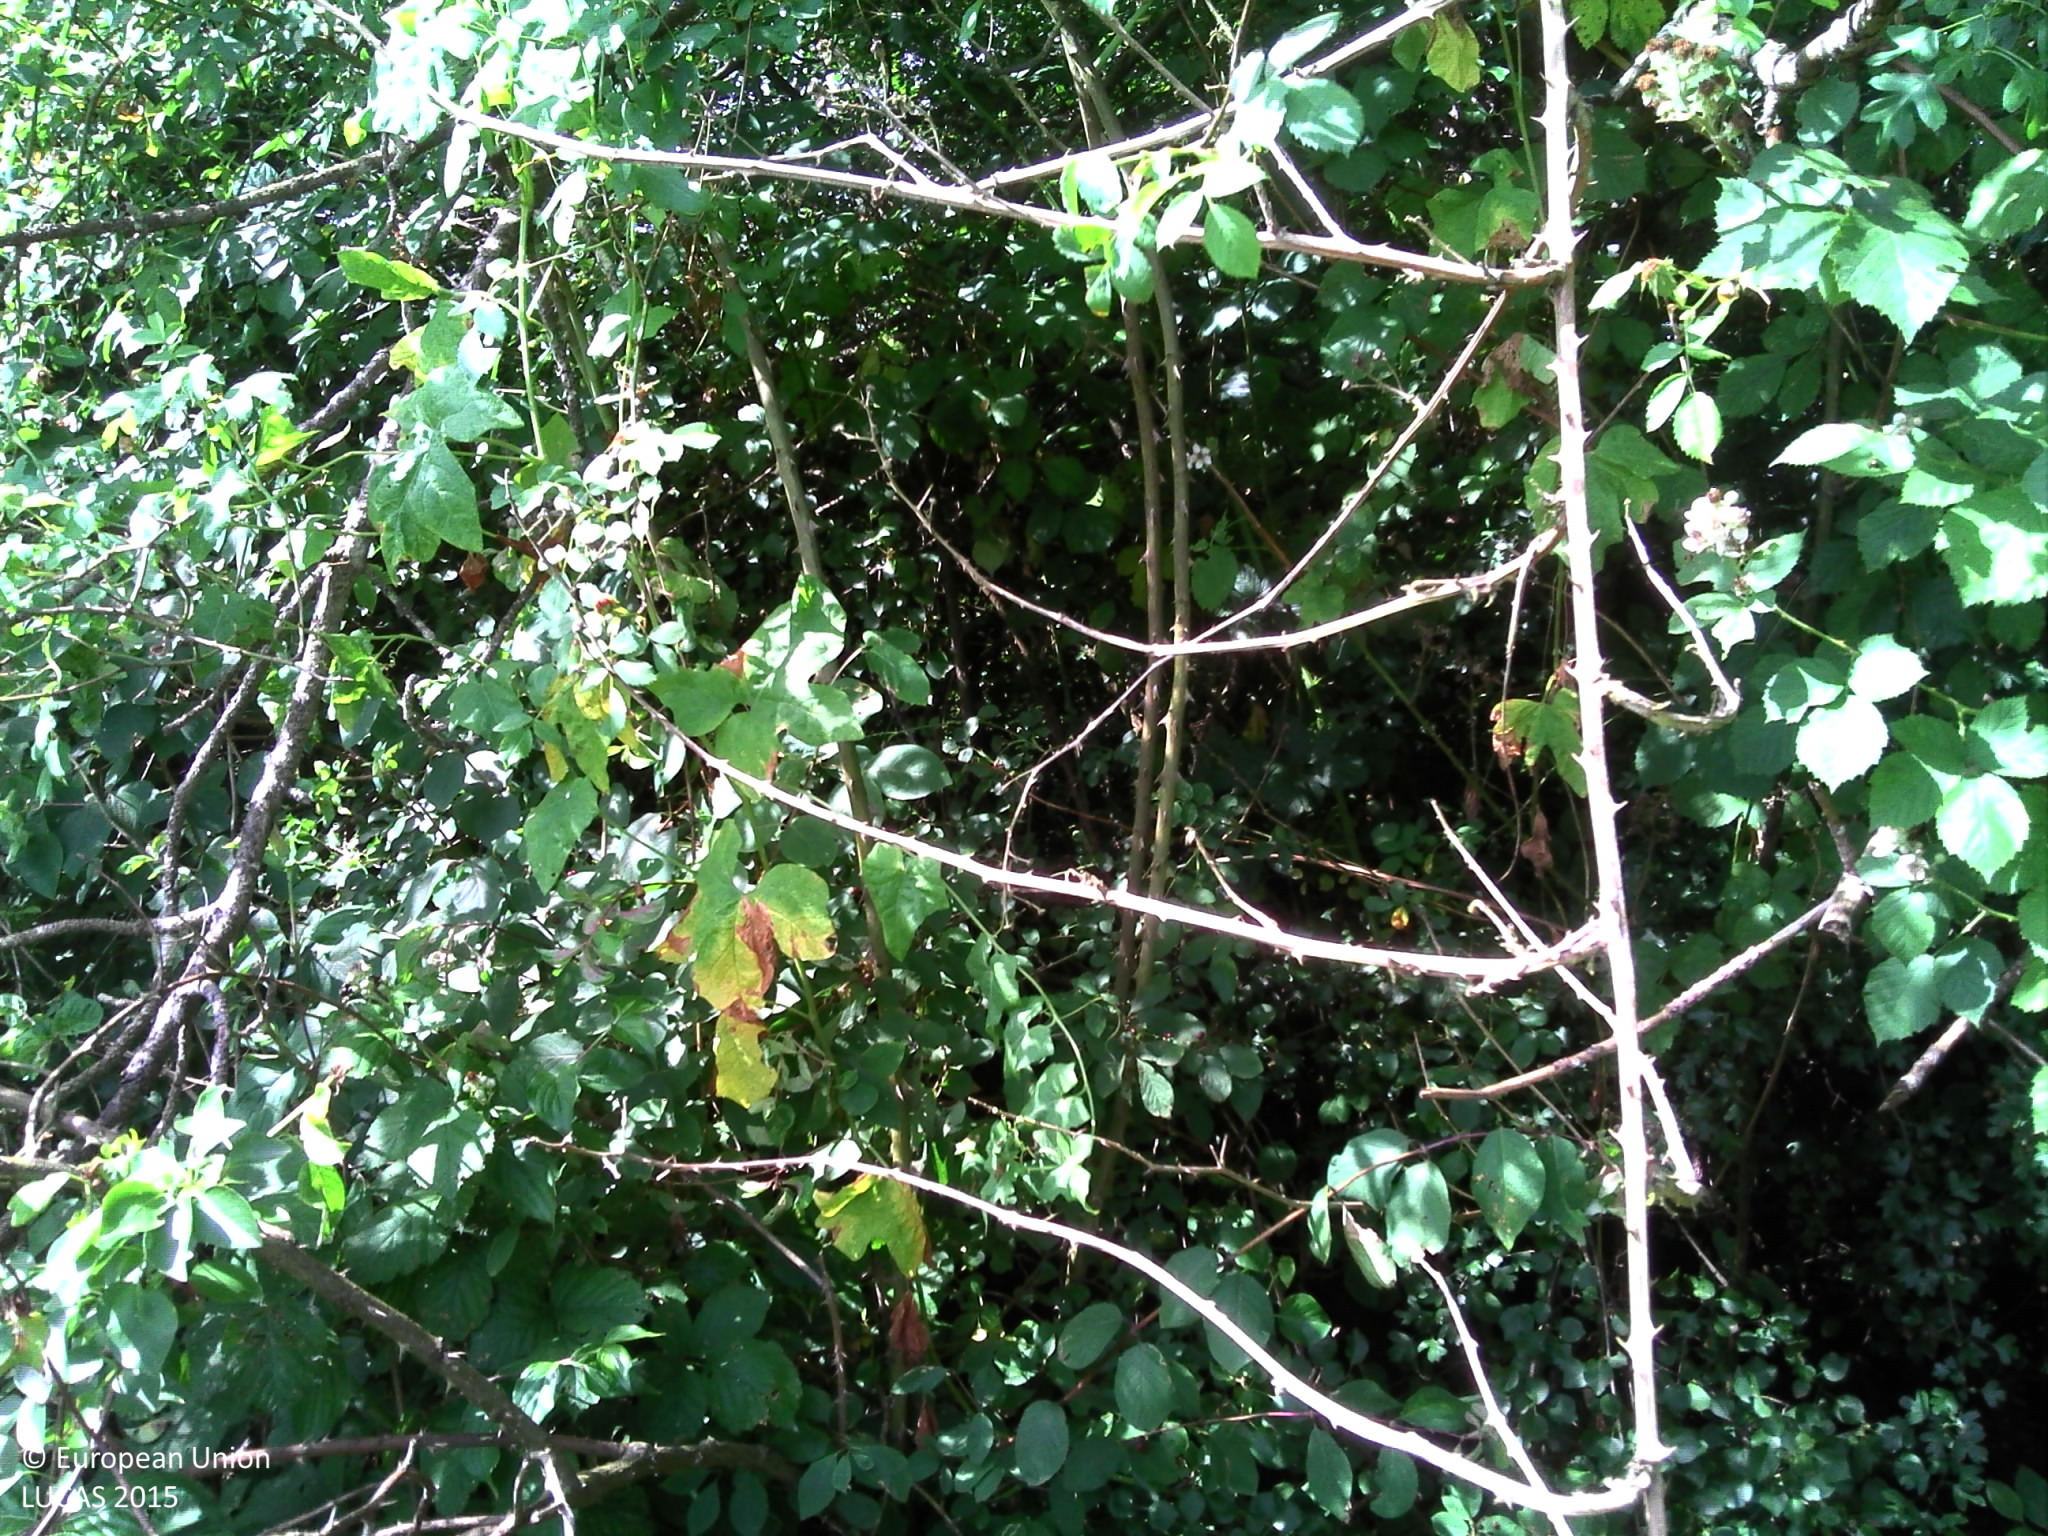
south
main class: Woodland
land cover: Pine dominated mixed woodland
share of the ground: 25 - 50 %
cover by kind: coniferous forest trees 50 %, broadleaved forest trees 30 %, shrubs 10 %, herbaceous plants 10 %
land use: Semi-natural and natural areas not in use
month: June
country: FR
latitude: 47.4350
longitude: 3.4862
